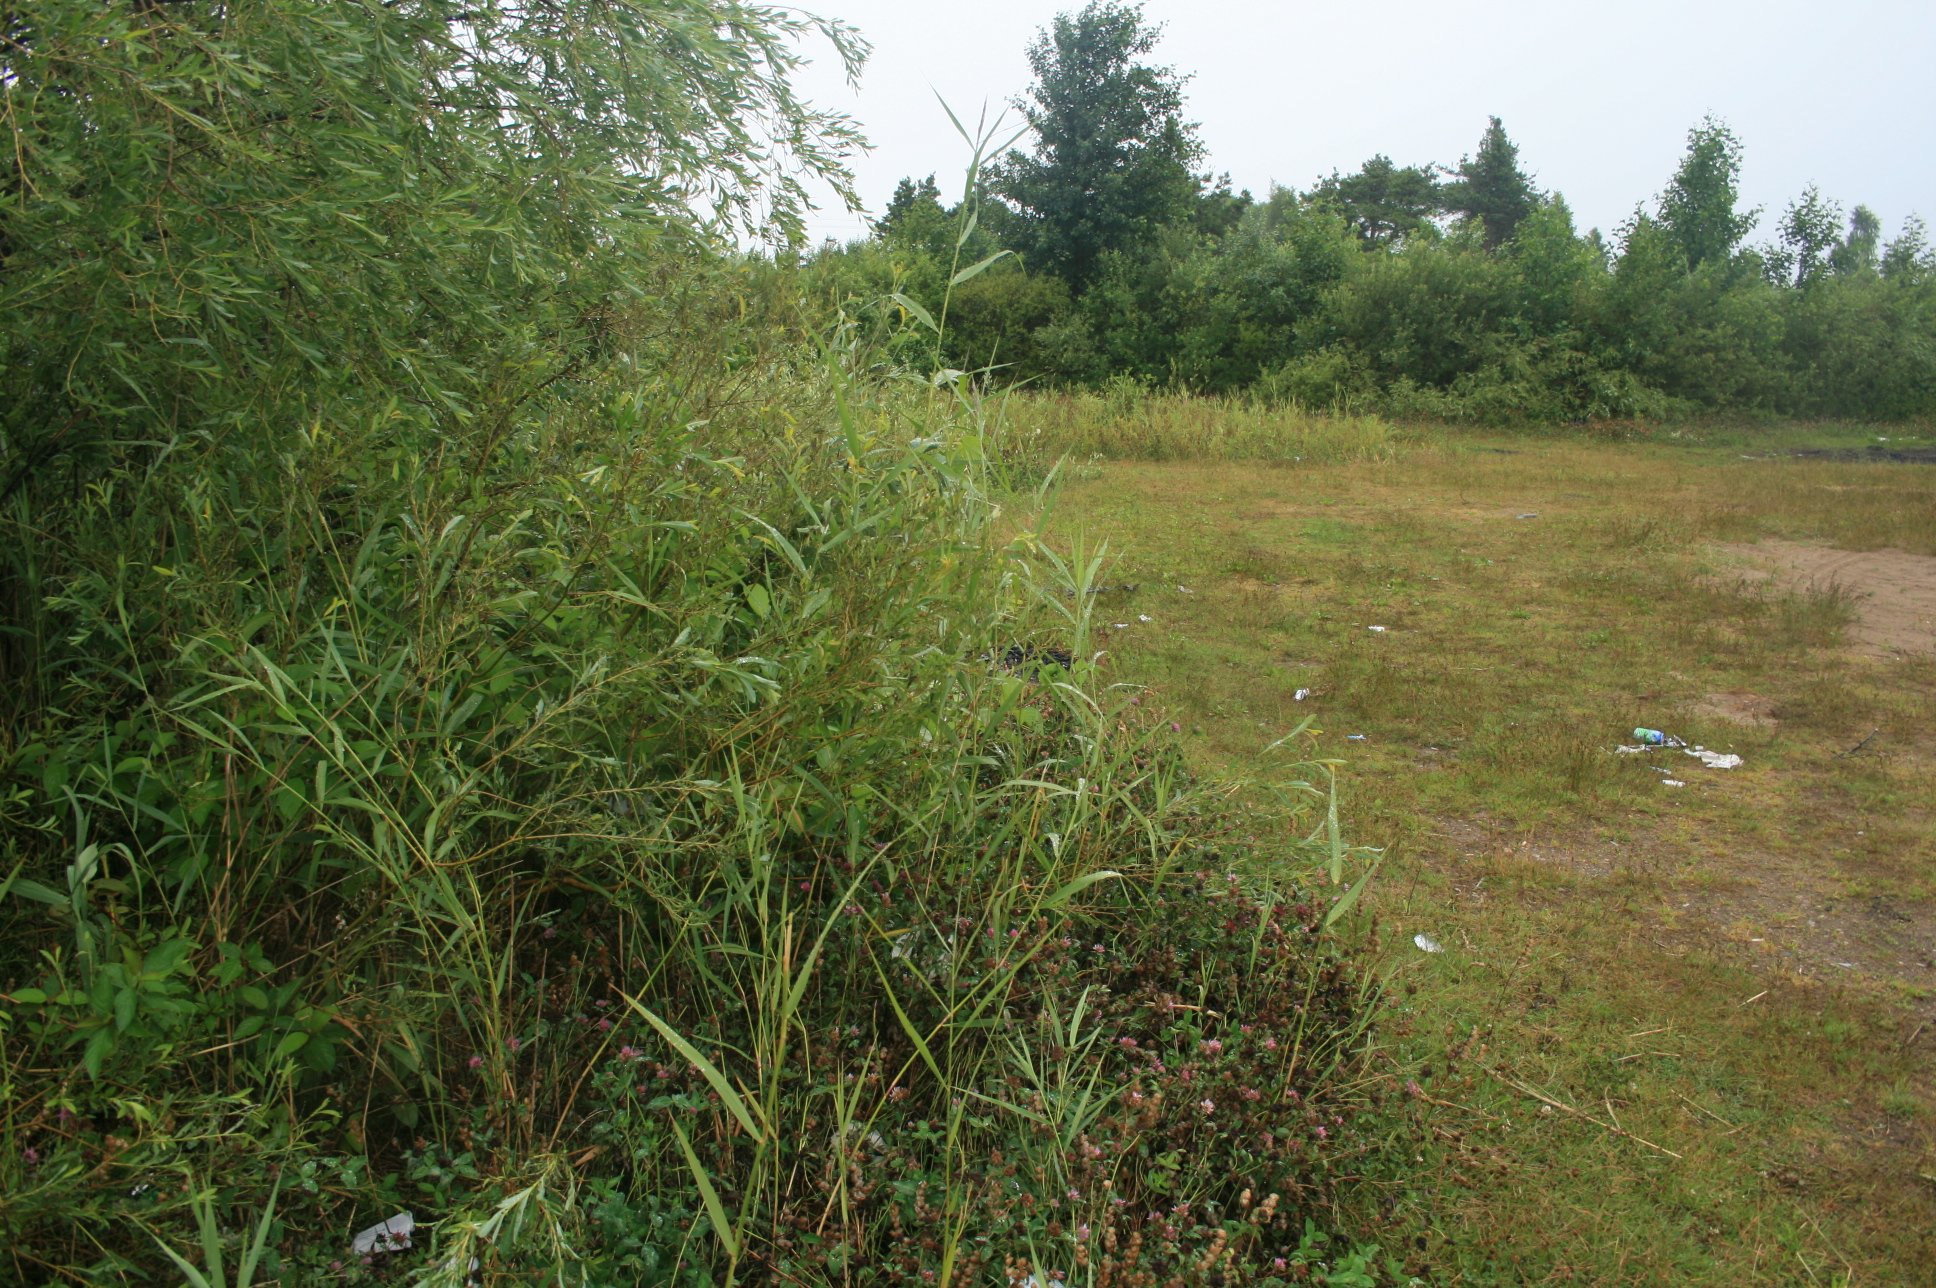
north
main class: Grassland
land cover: Grassland without tree/shrub cover
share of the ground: > 75 %
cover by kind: herbaceous plants 90 %, unconsolidated bare surface 10 %
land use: Amenities, museums, leisure
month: July
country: LT
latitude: 55.6431
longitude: 21.1788
